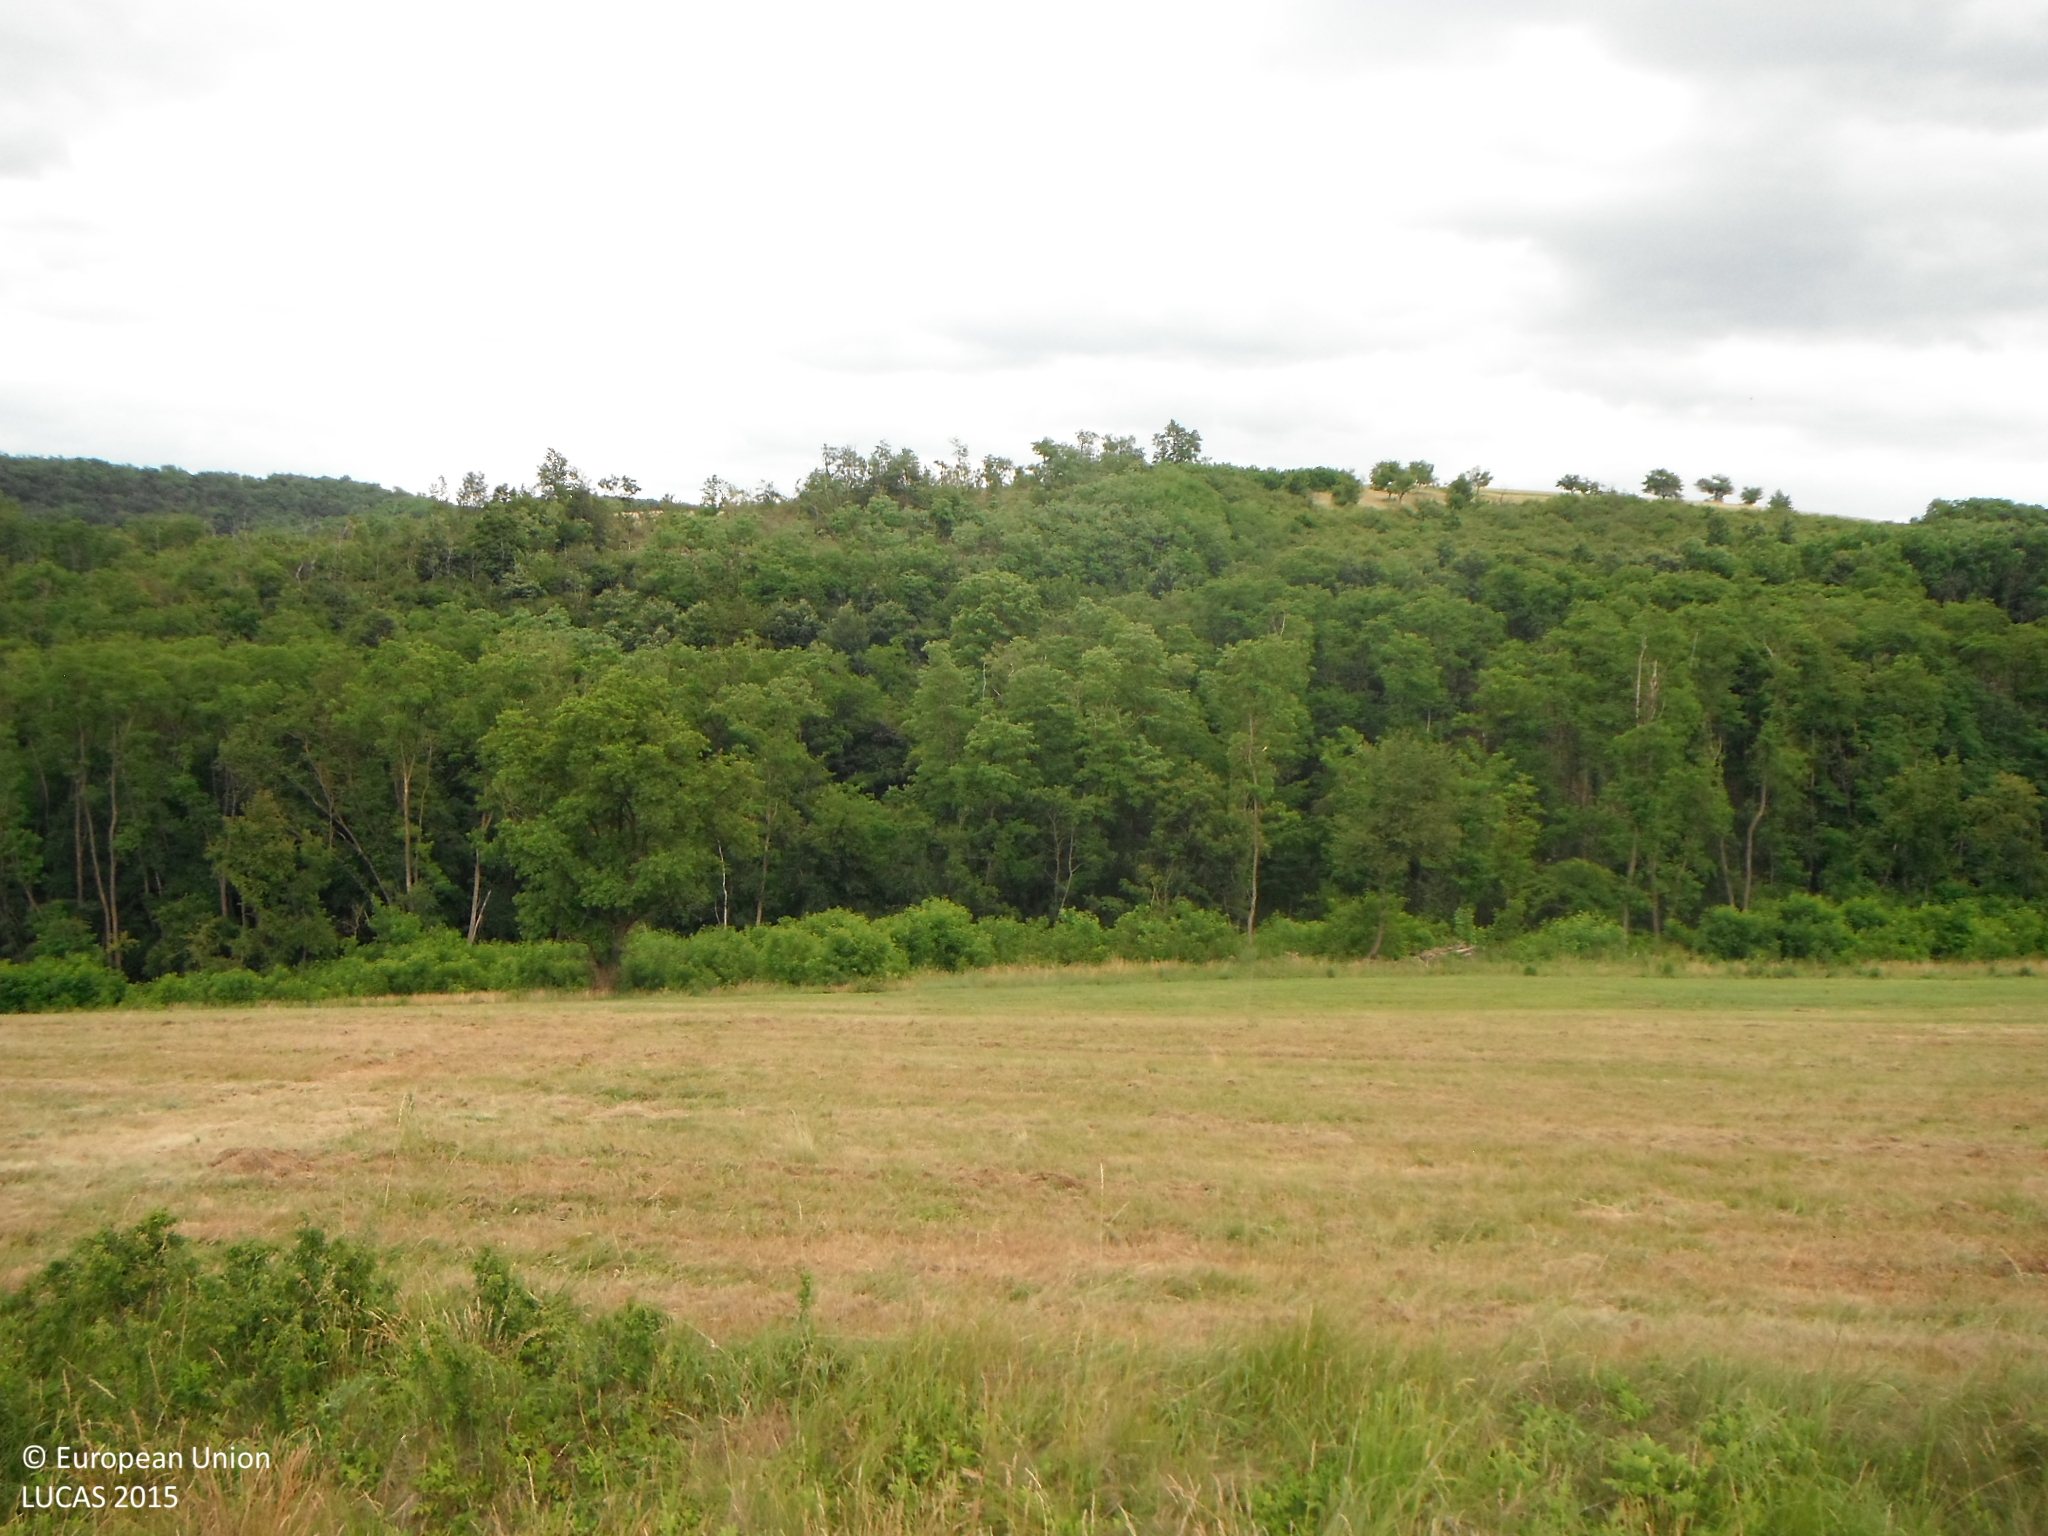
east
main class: Grassland
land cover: Grassland without tree/shrub cover
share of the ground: > 75 %
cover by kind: herbaceous plants 100 %
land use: Agriculture (excluding fallow land and kitchen gardens)
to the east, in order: Grassland without tree/shrub cover; Broadleaved woodland
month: June
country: SK
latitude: 48.1701
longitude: 18.9073
